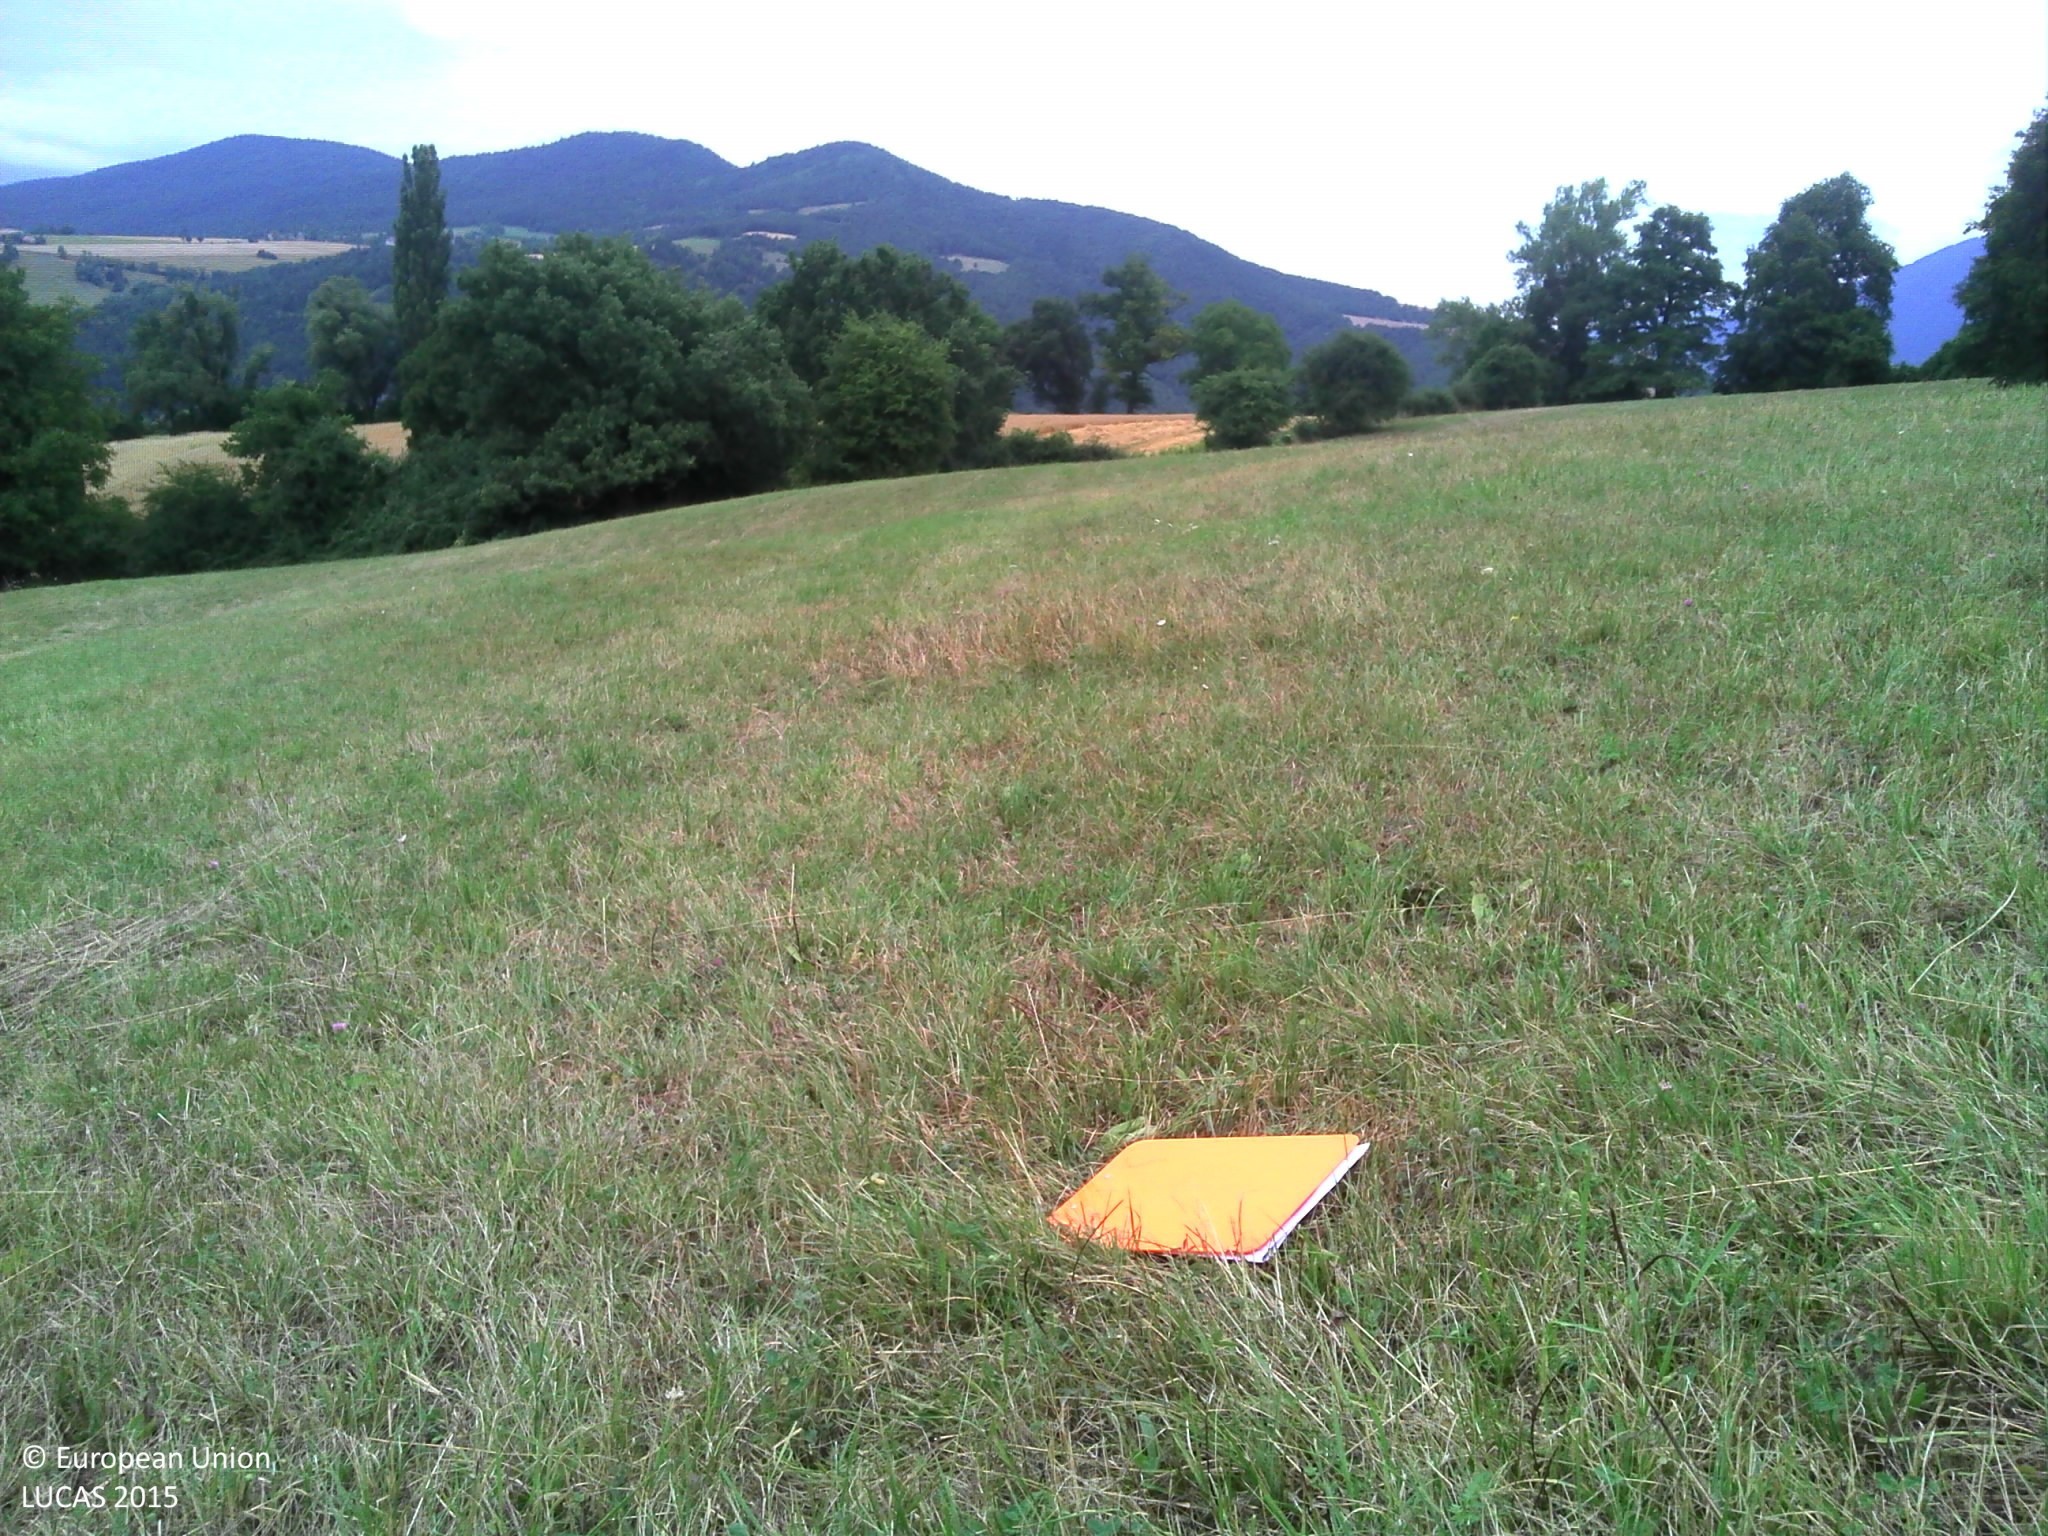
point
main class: Grassland
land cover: Grassland without tree/shrub cover
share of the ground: > 75 %
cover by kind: herbaceous plants 100 %
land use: Agriculture (excluding fallow land and kitchen gardens)
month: July
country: FR
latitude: 44.8559
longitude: 5.6657
